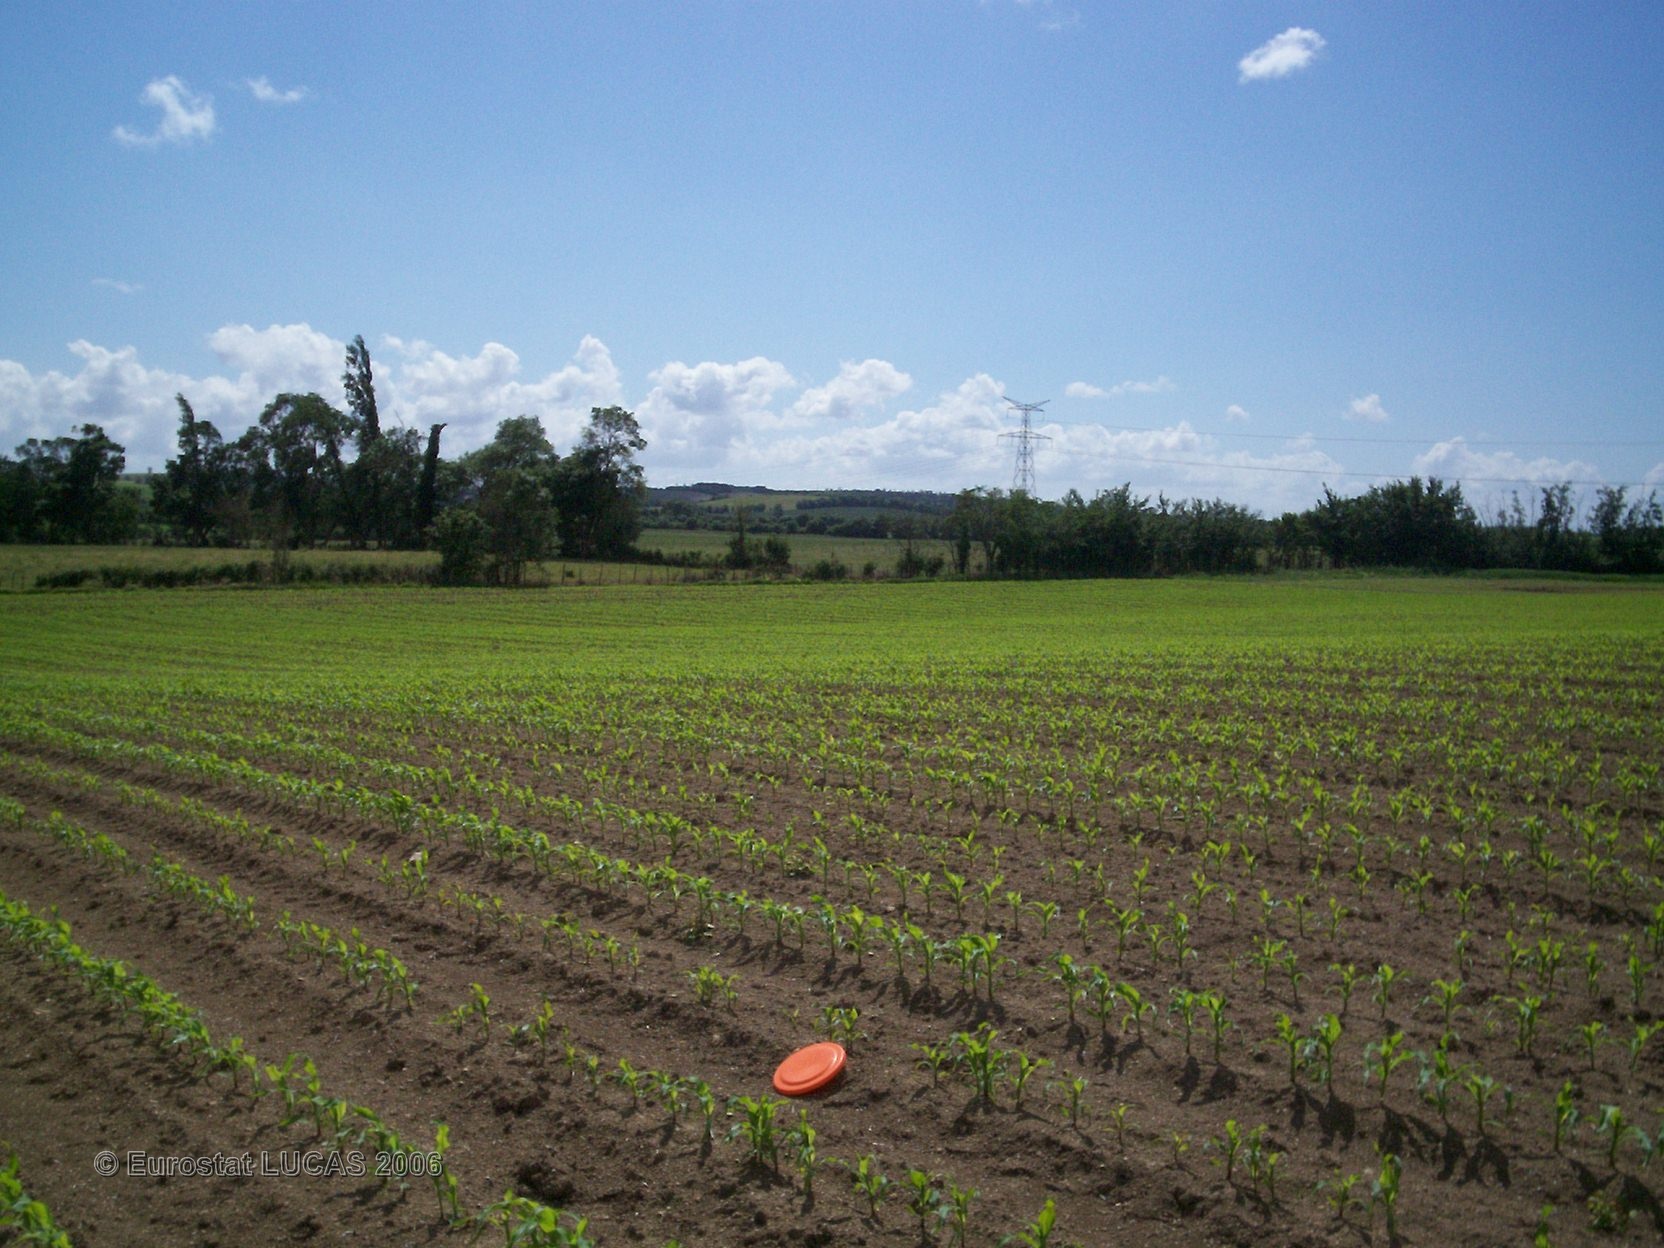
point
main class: Cropland
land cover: Maize
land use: Agriculture (excluding fallow land and kitchen gardens)
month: May
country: FR
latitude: 46.0324
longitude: -0.6851
